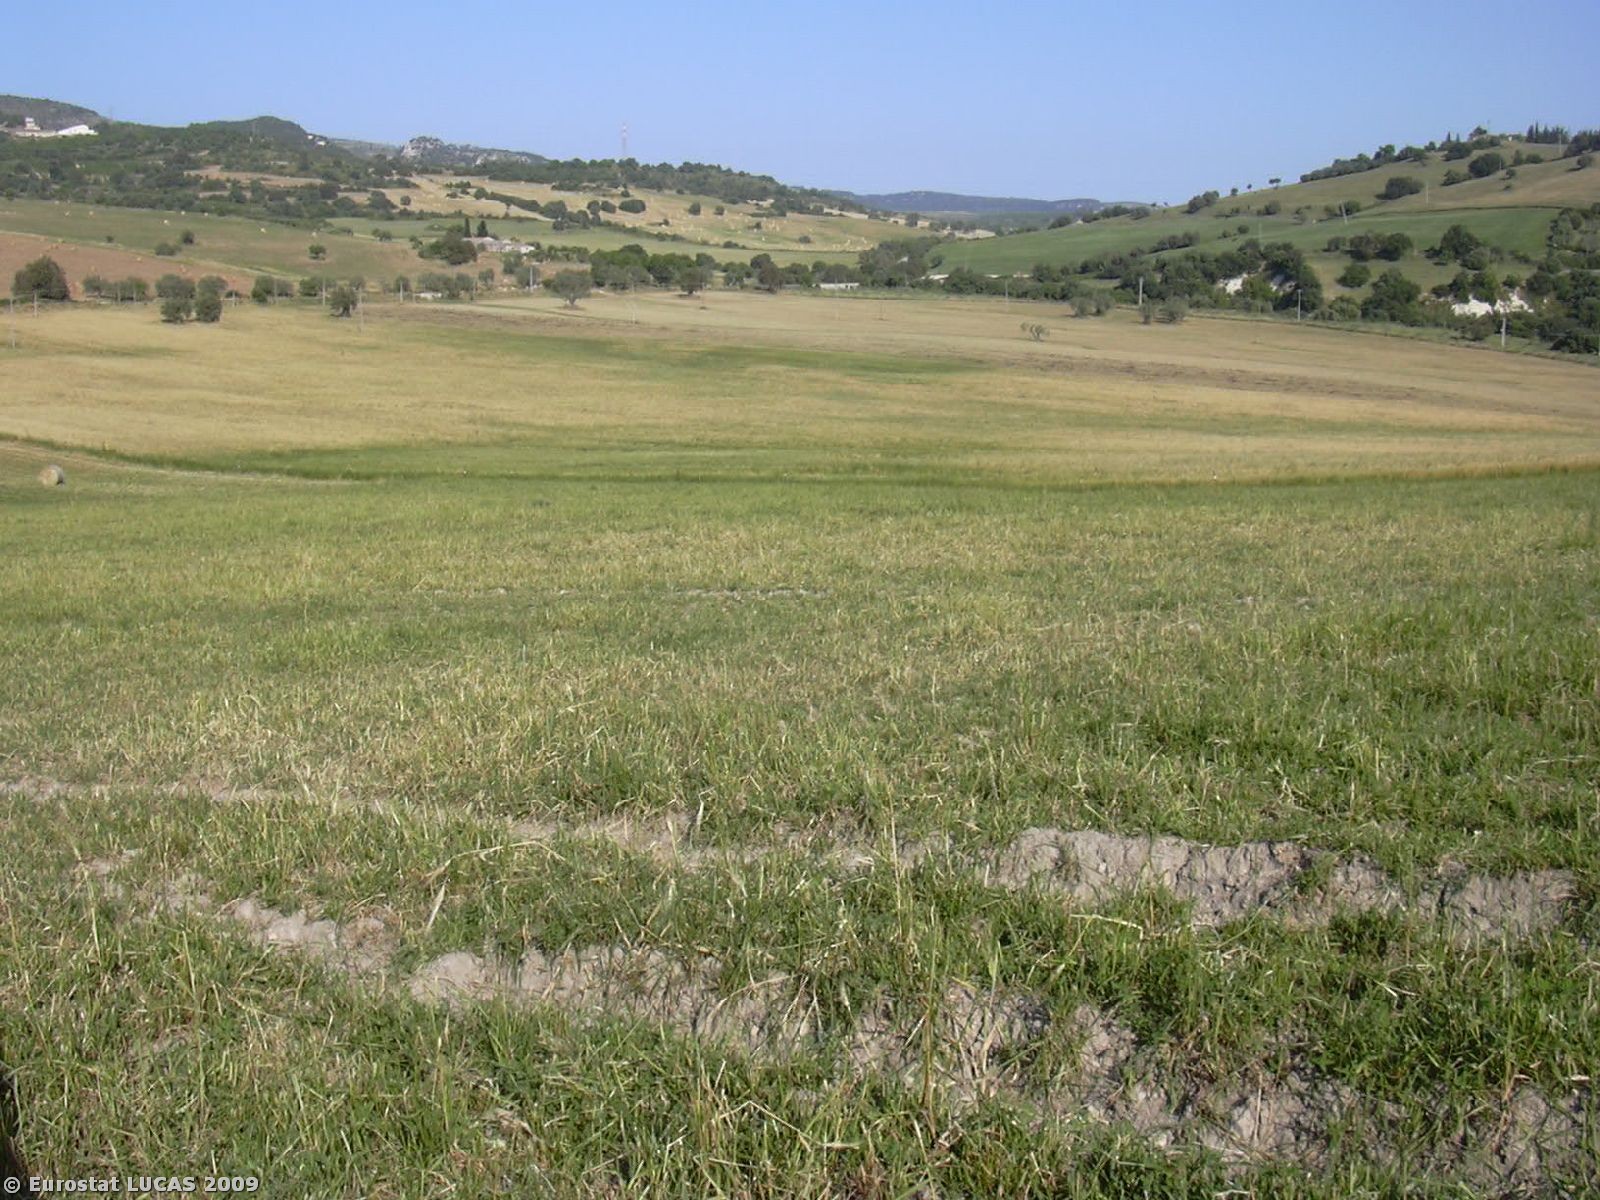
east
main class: Cropland
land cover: Mixed cereals for fodder
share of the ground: 50 - 75 %
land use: Agriculture (excluding fallow land and kitchen gardens)
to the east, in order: Mixed cereals for fodder; Durum wheat
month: May
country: IT
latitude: 36.9667
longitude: 14.8926
